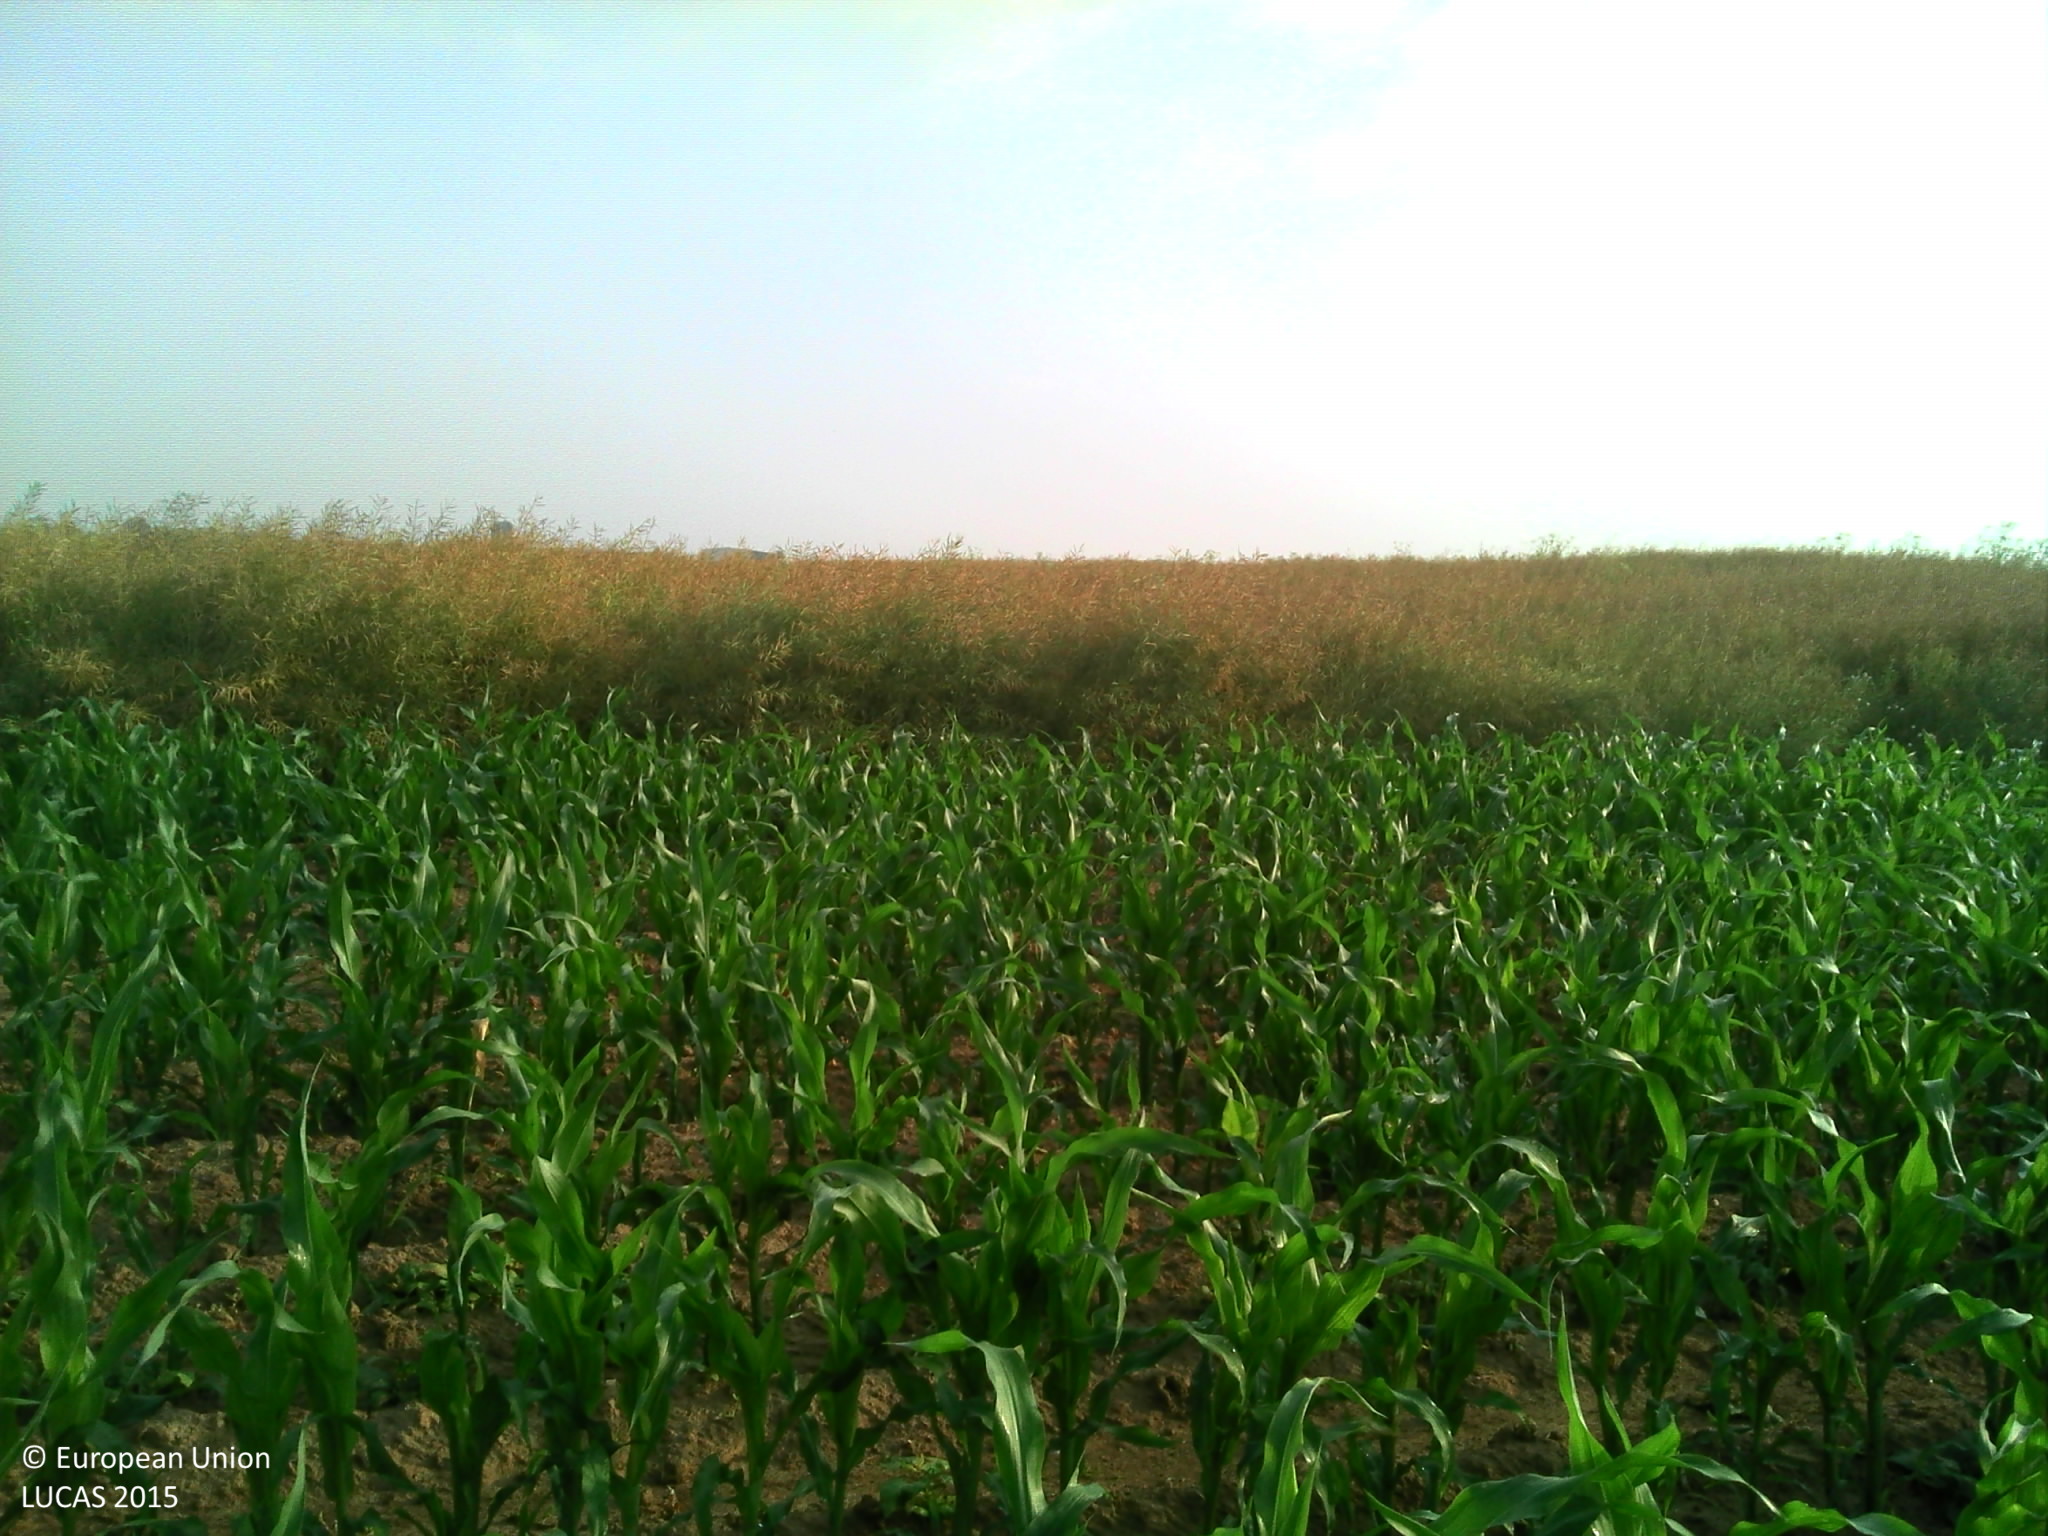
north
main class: Cropland
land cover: Maize
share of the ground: 25 - 50 %
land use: Agriculture (excluding fallow land and kitchen gardens)
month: July
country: FR
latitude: 49.7426
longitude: 2.5640
